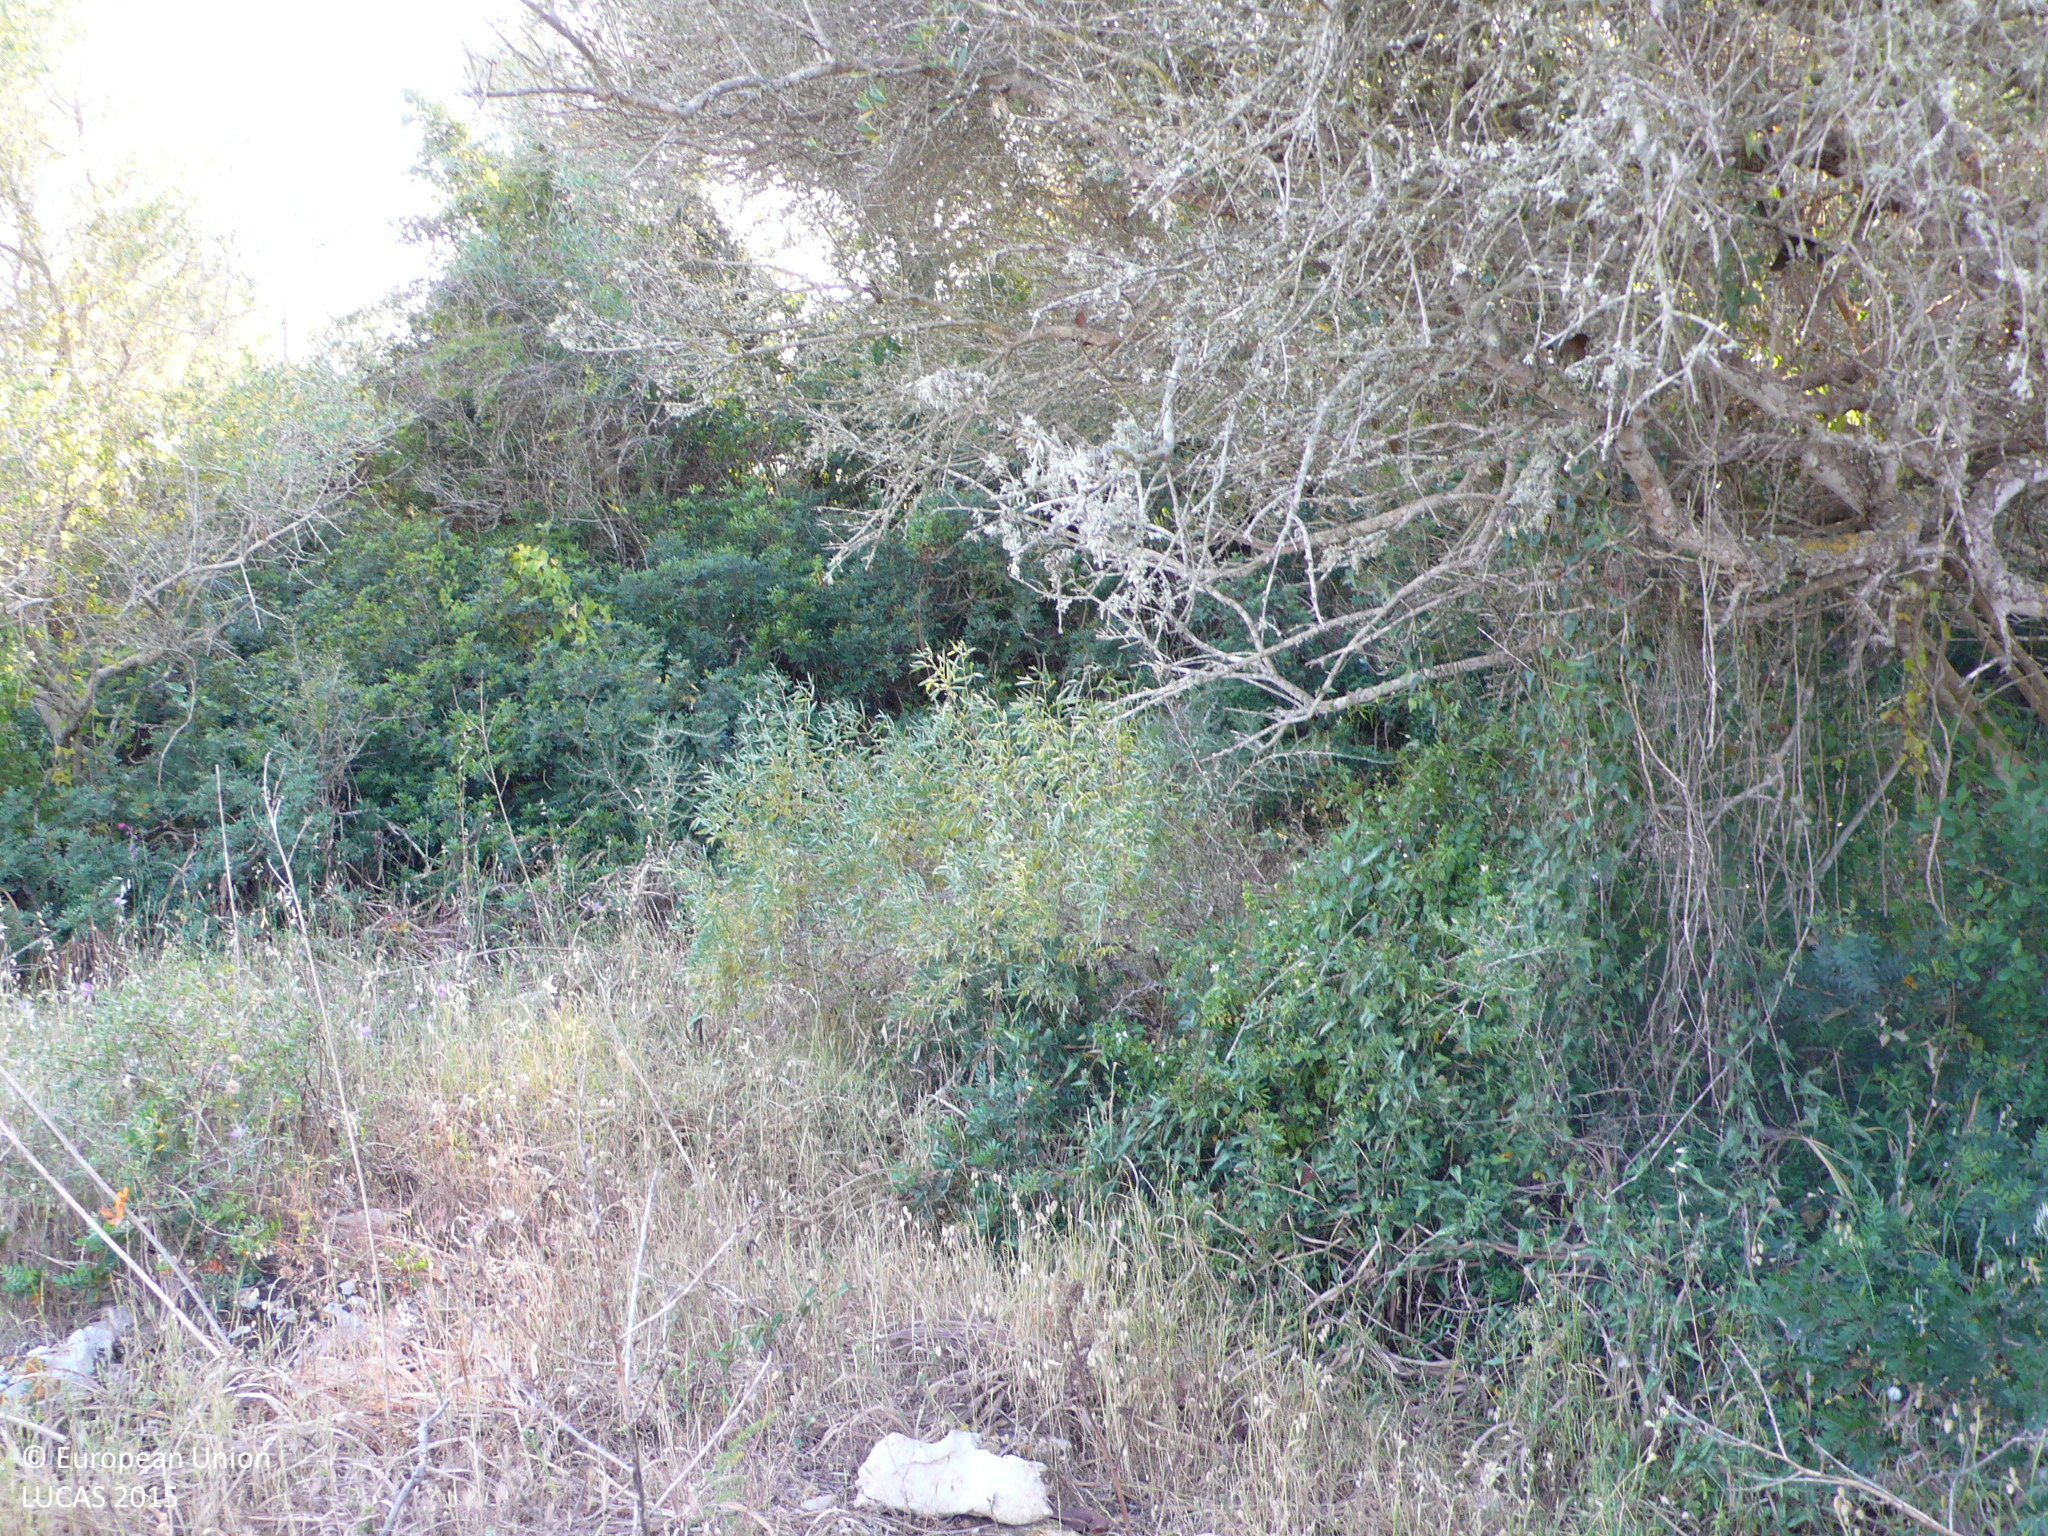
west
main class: Woodland
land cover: Broadleaved woodland
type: broadleaved evergreen forest
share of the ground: 25 - 50 %
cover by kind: herbaceous plants 40 %, shrubs 30 %, broadleaved forest trees 25 %, consolidated bare surface 5 %
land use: Semi-natural and natural areas not in use
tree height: > 5 m
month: May
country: ES
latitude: 39.8747
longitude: 4.1454
